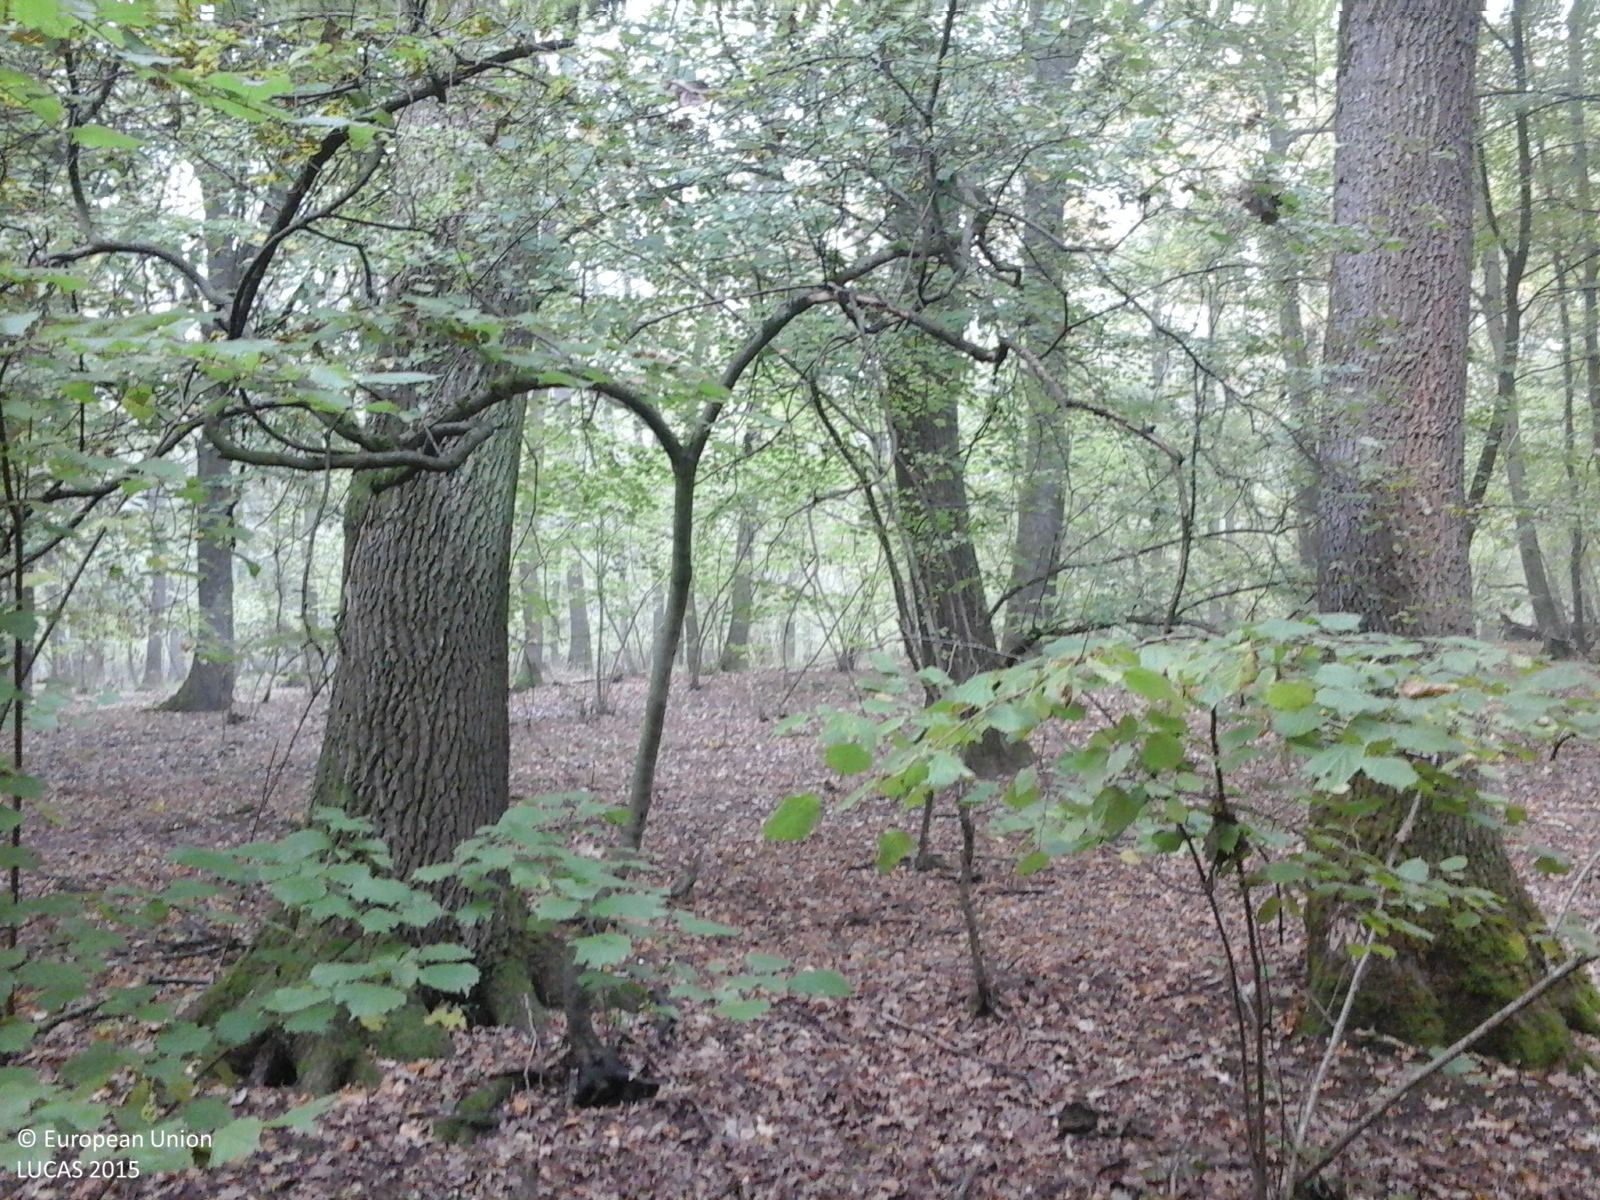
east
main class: Woodland
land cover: Broadleaved woodland
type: mesophytic deciduous forest
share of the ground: > 75 %
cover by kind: broadleaved forest trees 100 %
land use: Forestry
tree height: > 5 m
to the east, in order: Broadleaved woodland
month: October
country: RO
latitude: 46.3409
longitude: 24.2555
